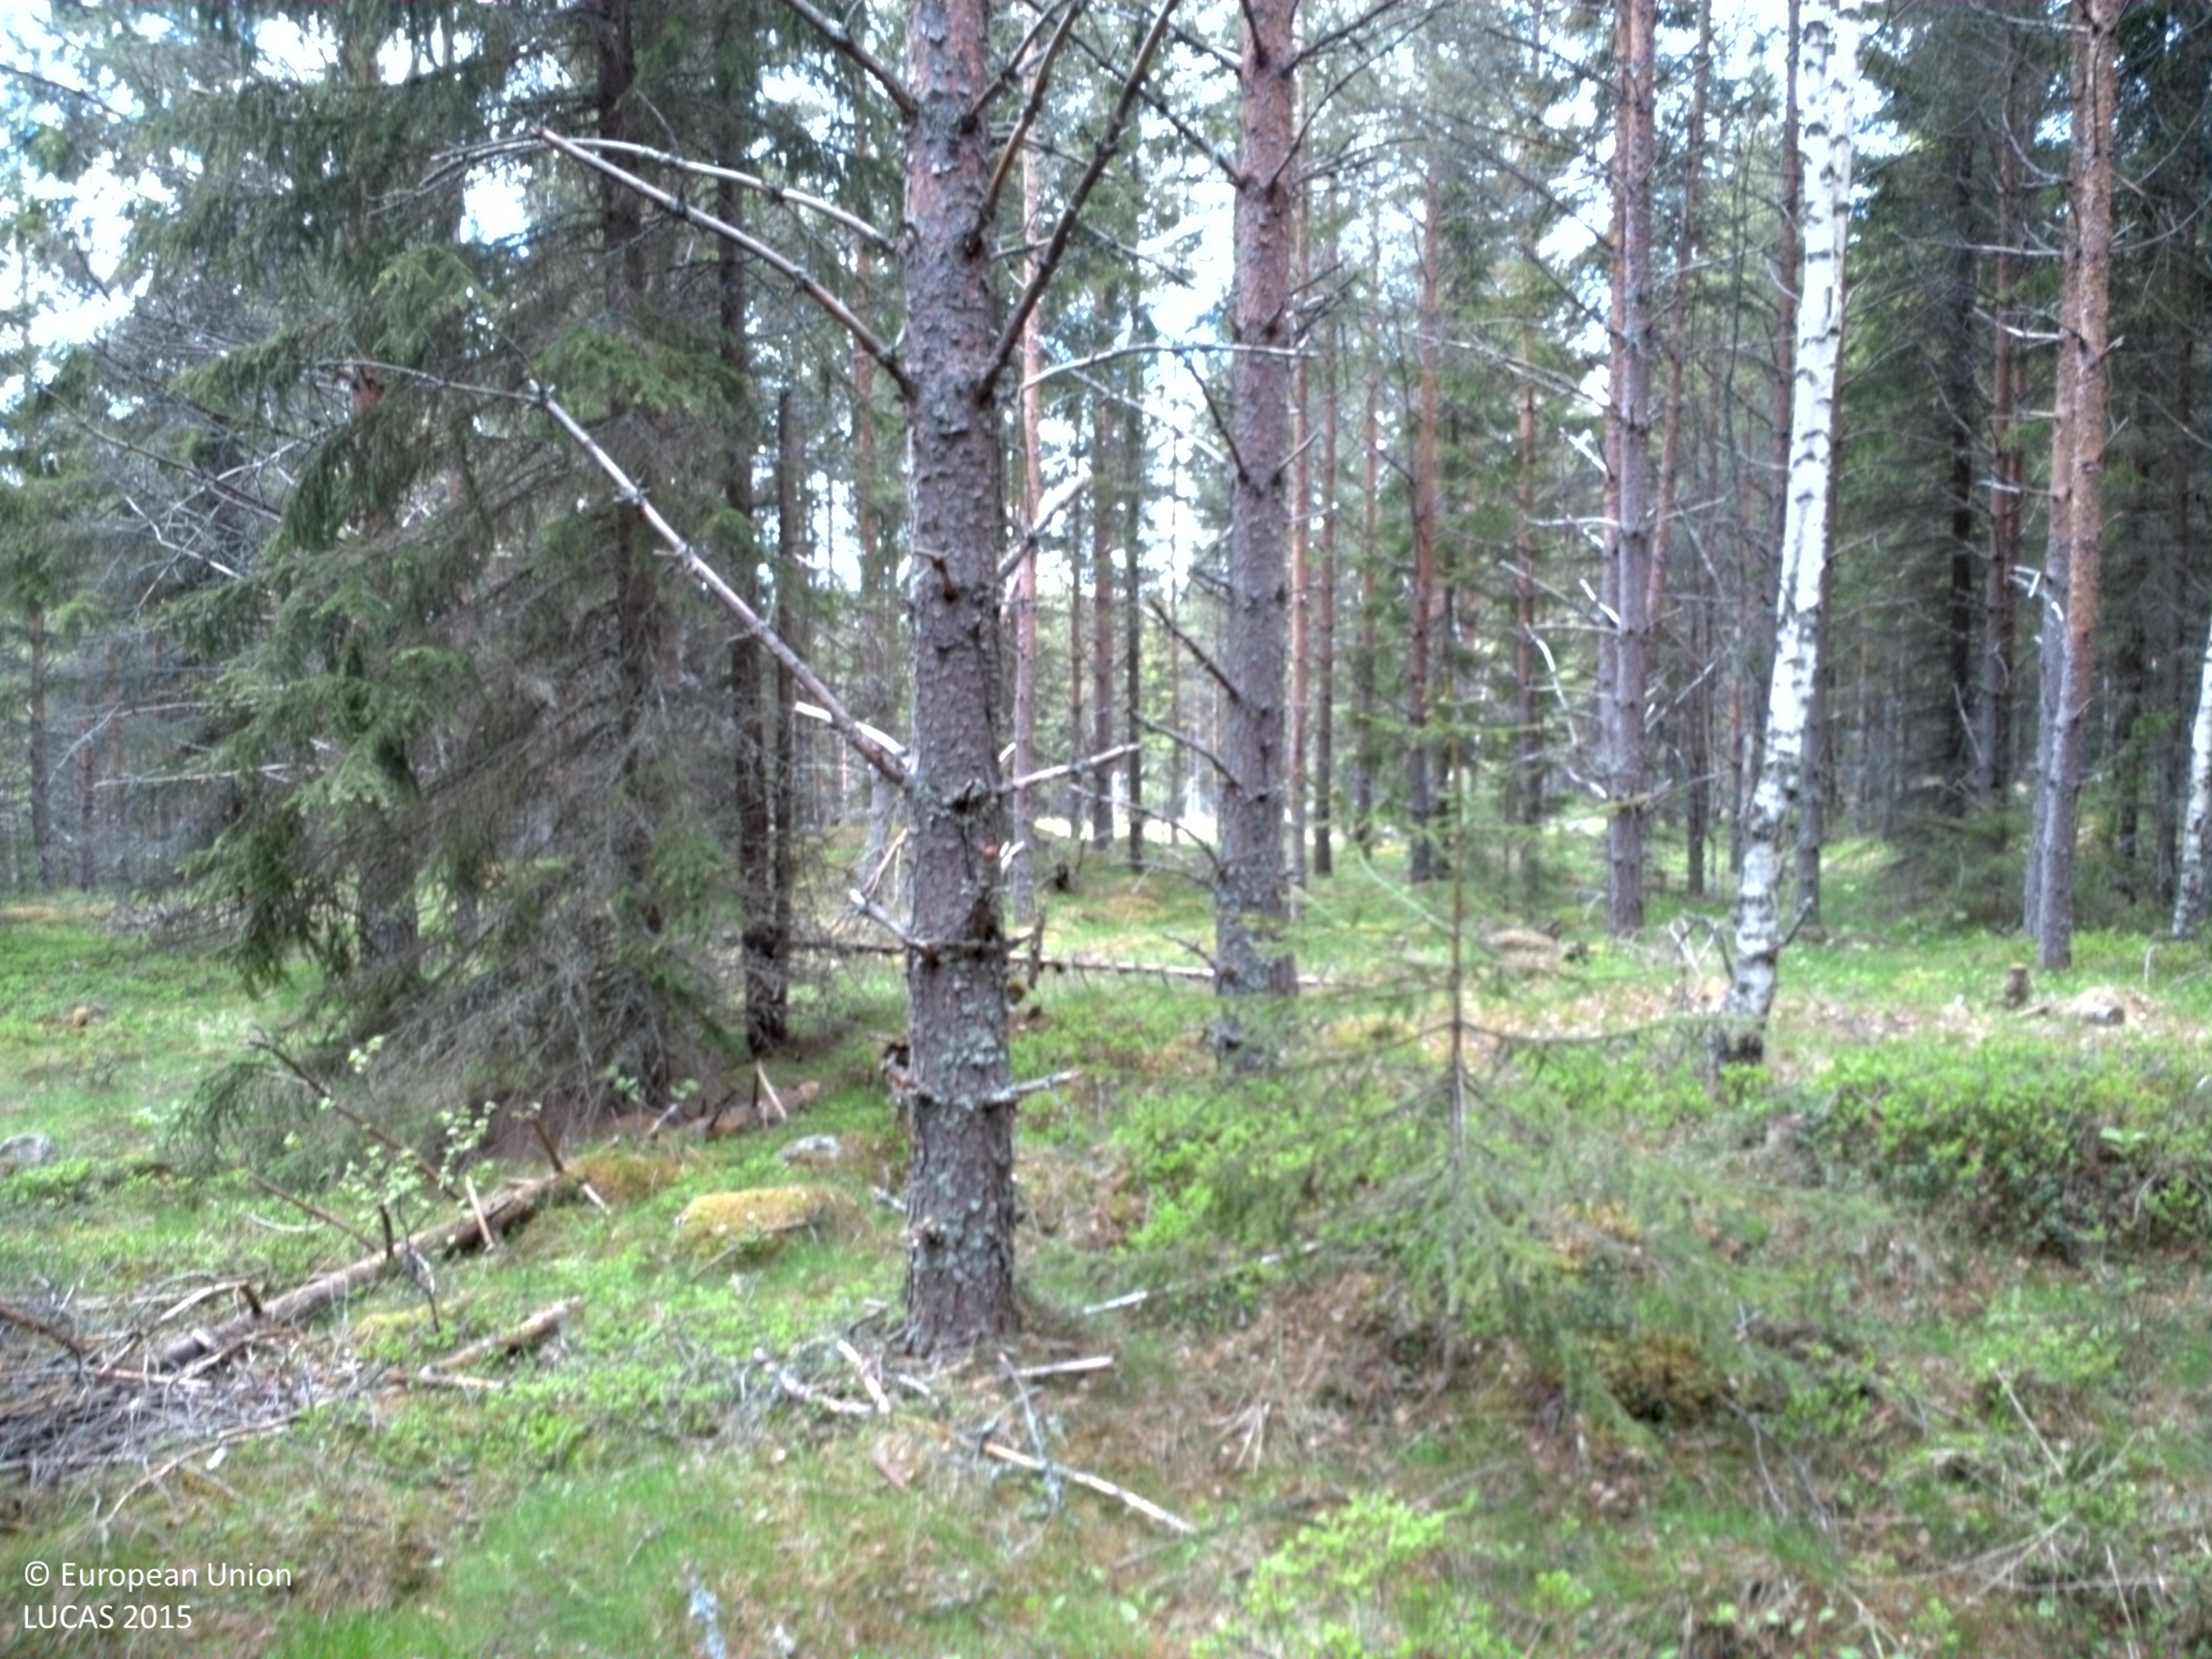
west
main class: Woodland
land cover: Pine dominated coniferous woodland
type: boreal forest
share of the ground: 50 - 75 %
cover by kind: coniferous forest trees 65 %, herbaceous plants 30 %, lichens and mosses 5 %
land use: Forestry
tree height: > 5 m
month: May
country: SE
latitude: 61.2822
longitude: 15.5258
